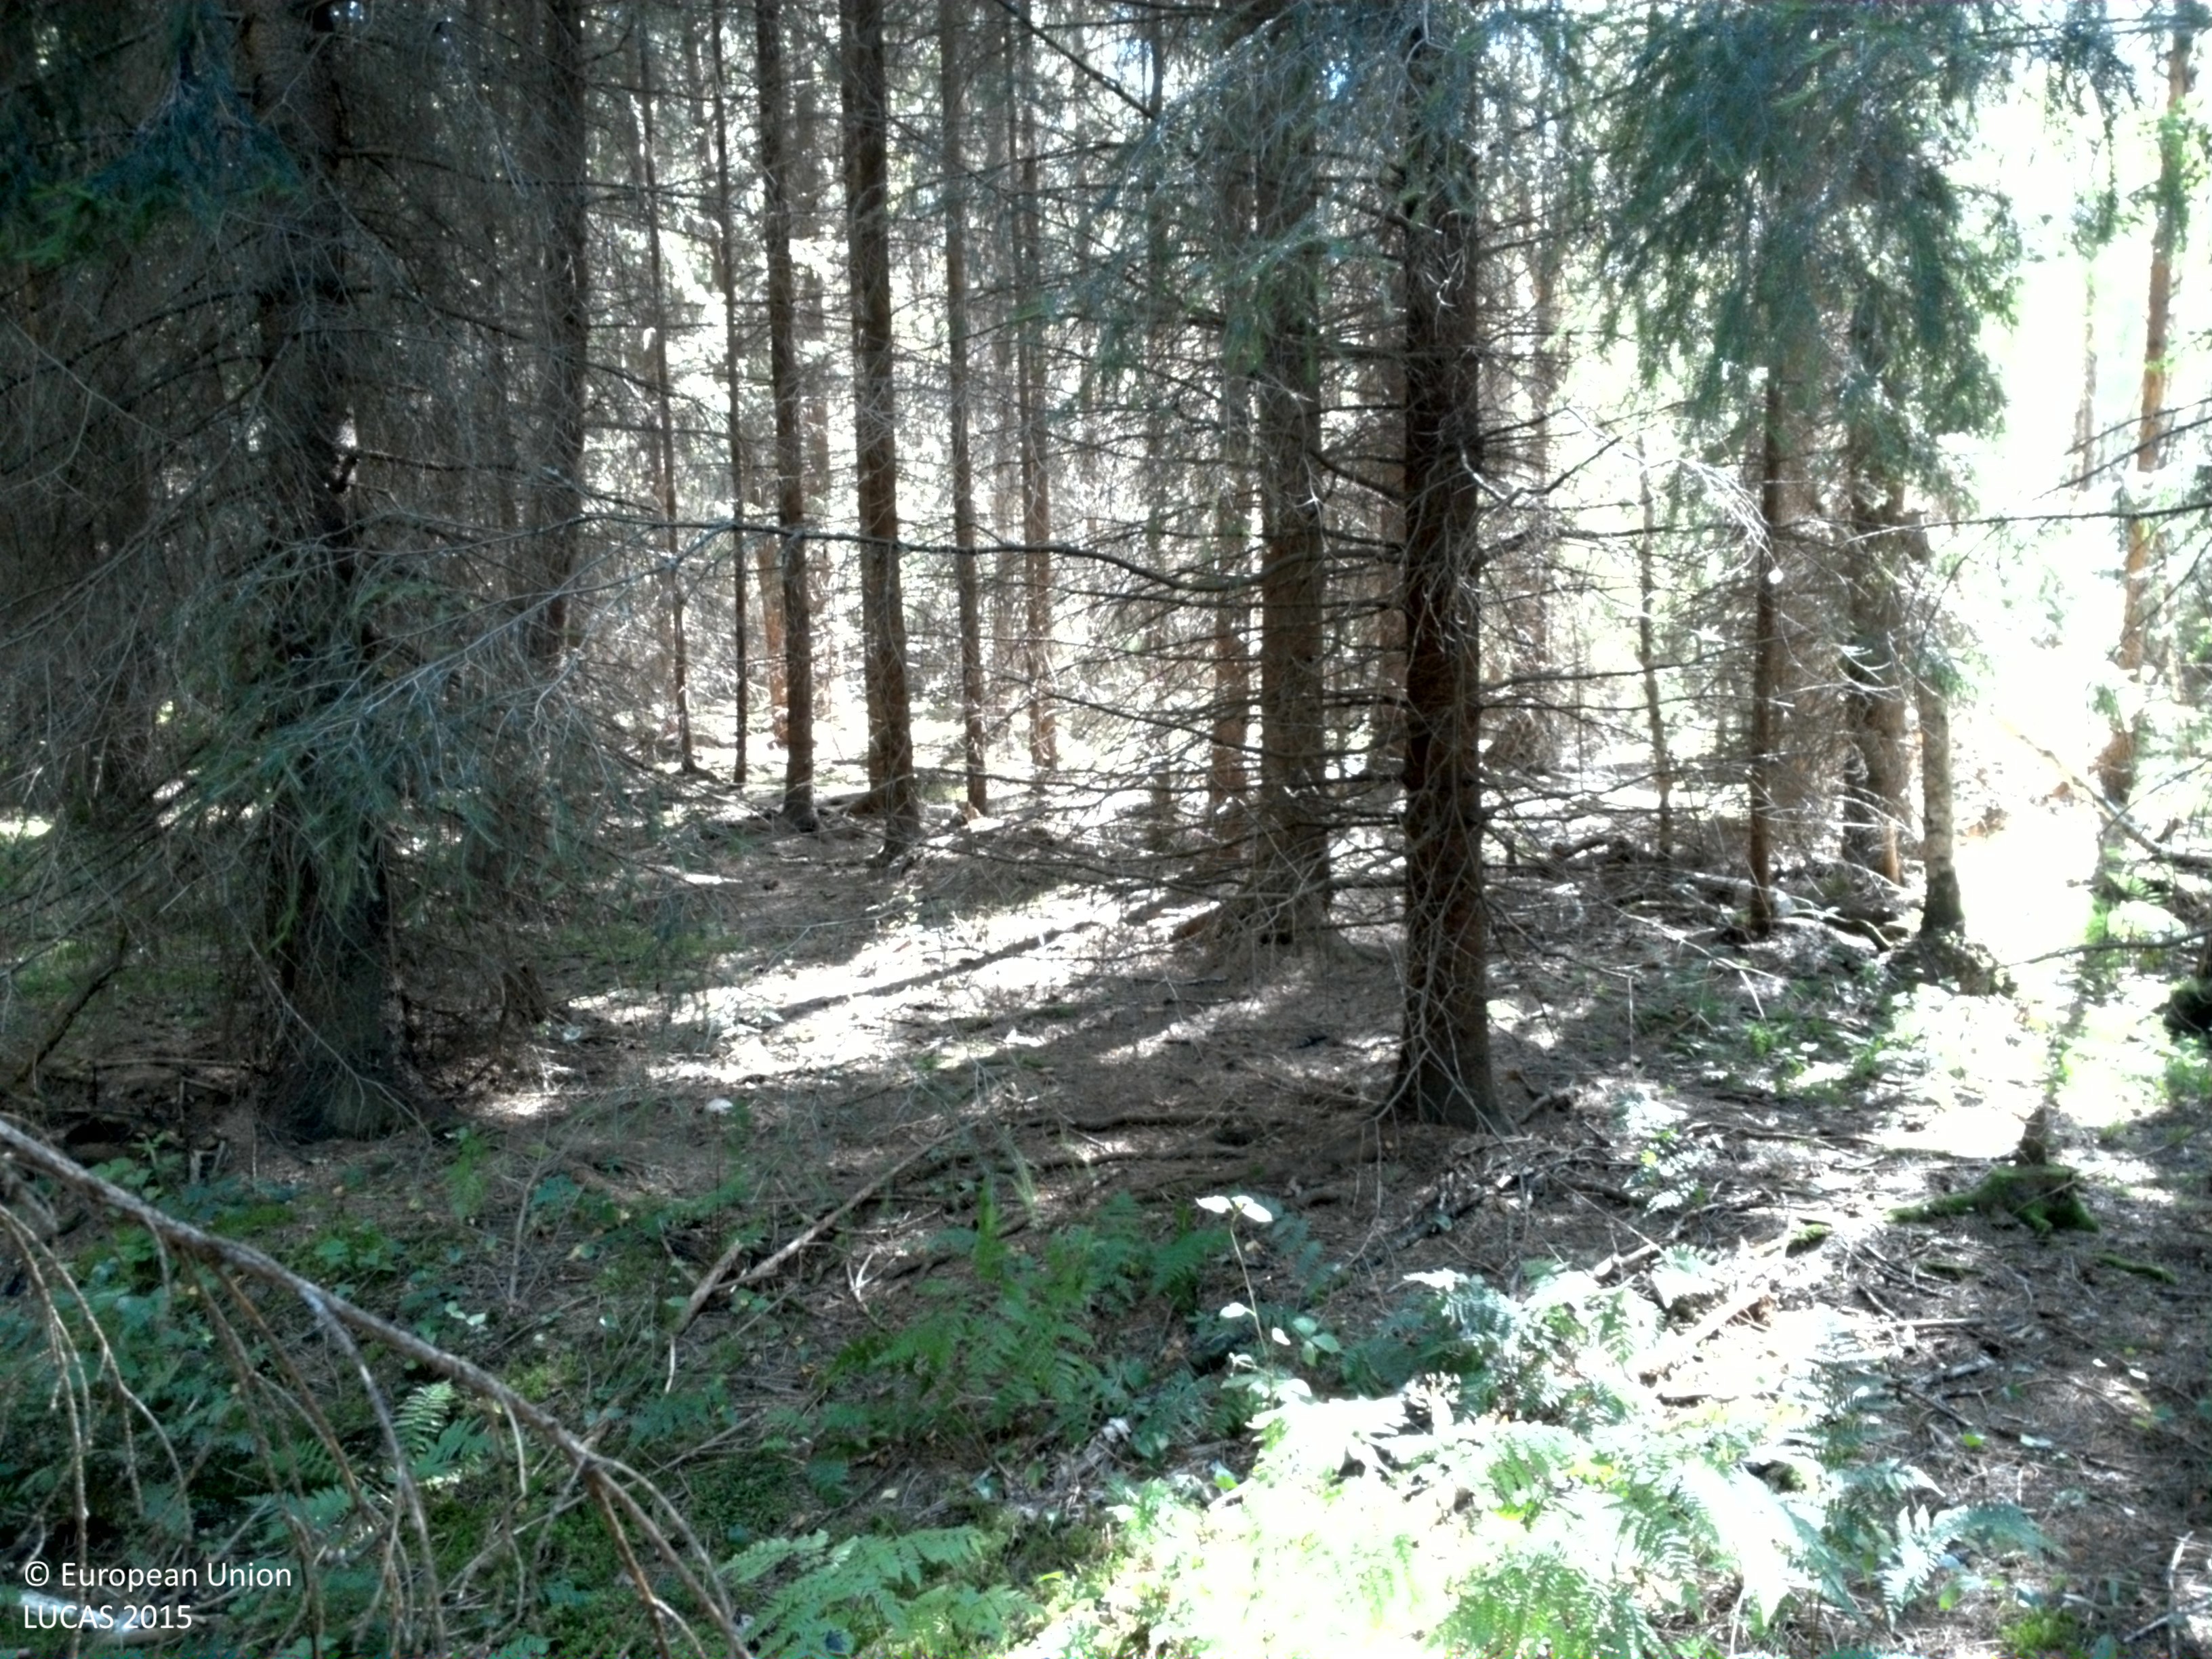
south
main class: Woodland
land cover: Spruce dominated coniferous woodland
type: boreal forest
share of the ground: > 75 %
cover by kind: coniferous forest trees 80 %, broadleaved forest trees 5 %, herbaceous plants 5 %, lichens and mosses 5 %, unconsolidated bare surface 5 %
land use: Forestry
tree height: > 5 m
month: August
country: SE
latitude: 59.9753
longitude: 17.9322
